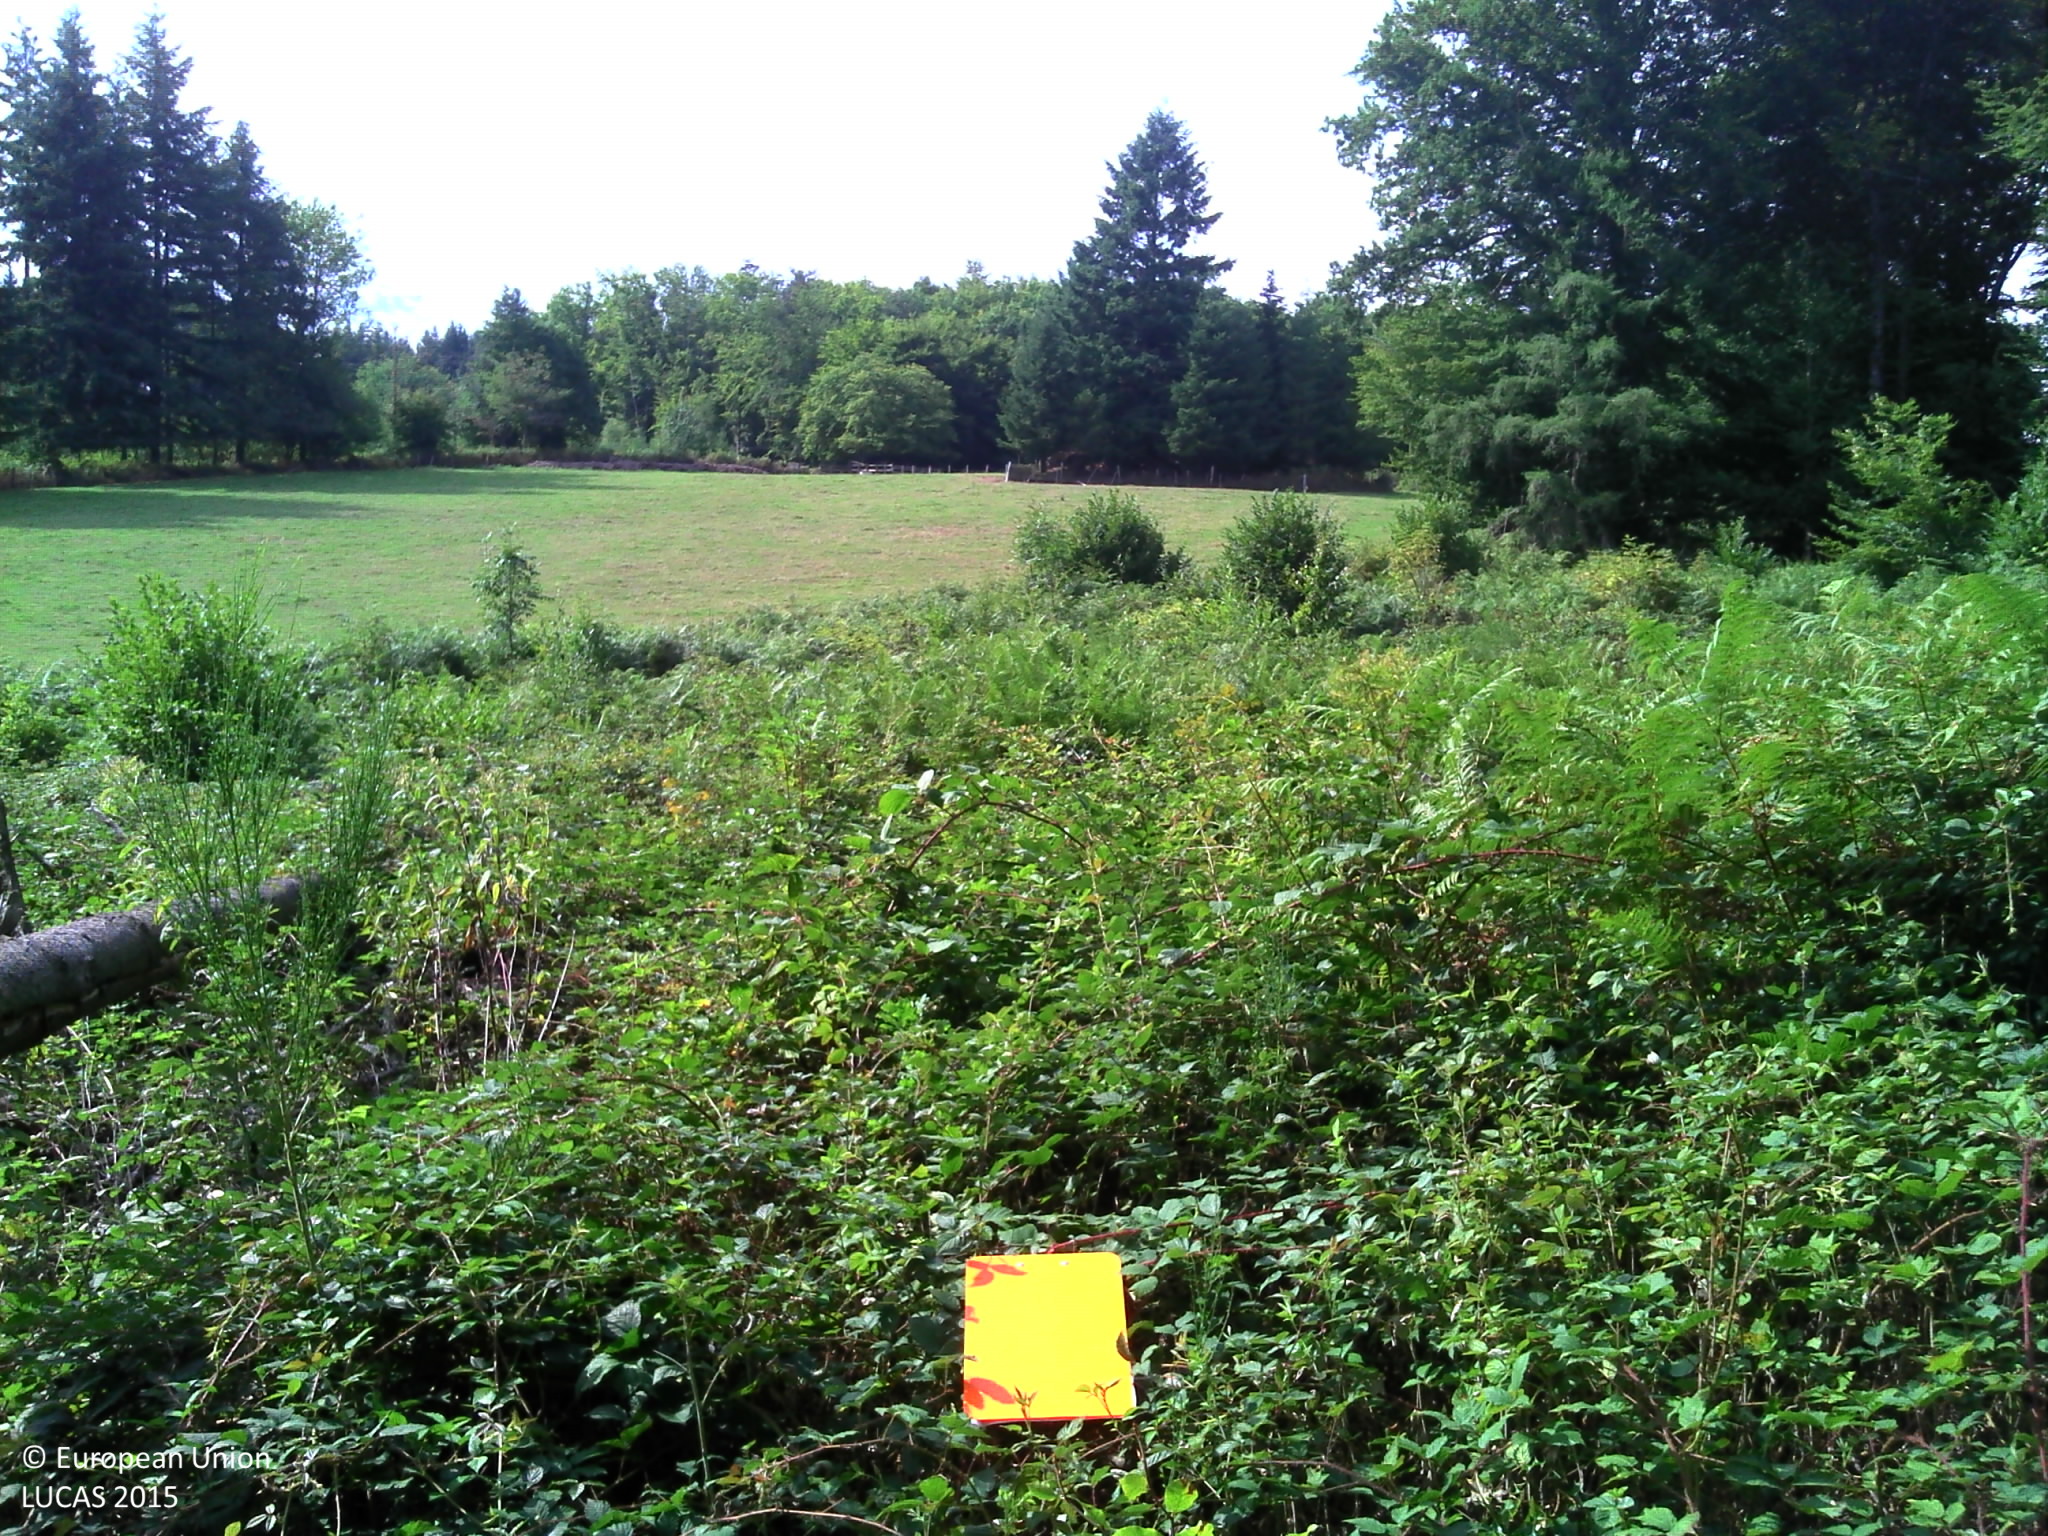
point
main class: Shrubland
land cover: Shrubland without tree cover
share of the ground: > 75 %
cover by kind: shrubs 80 %, herbaceous plants 20 %
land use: Forestry
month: August
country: FR
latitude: 46.2951
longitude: 4.4066
